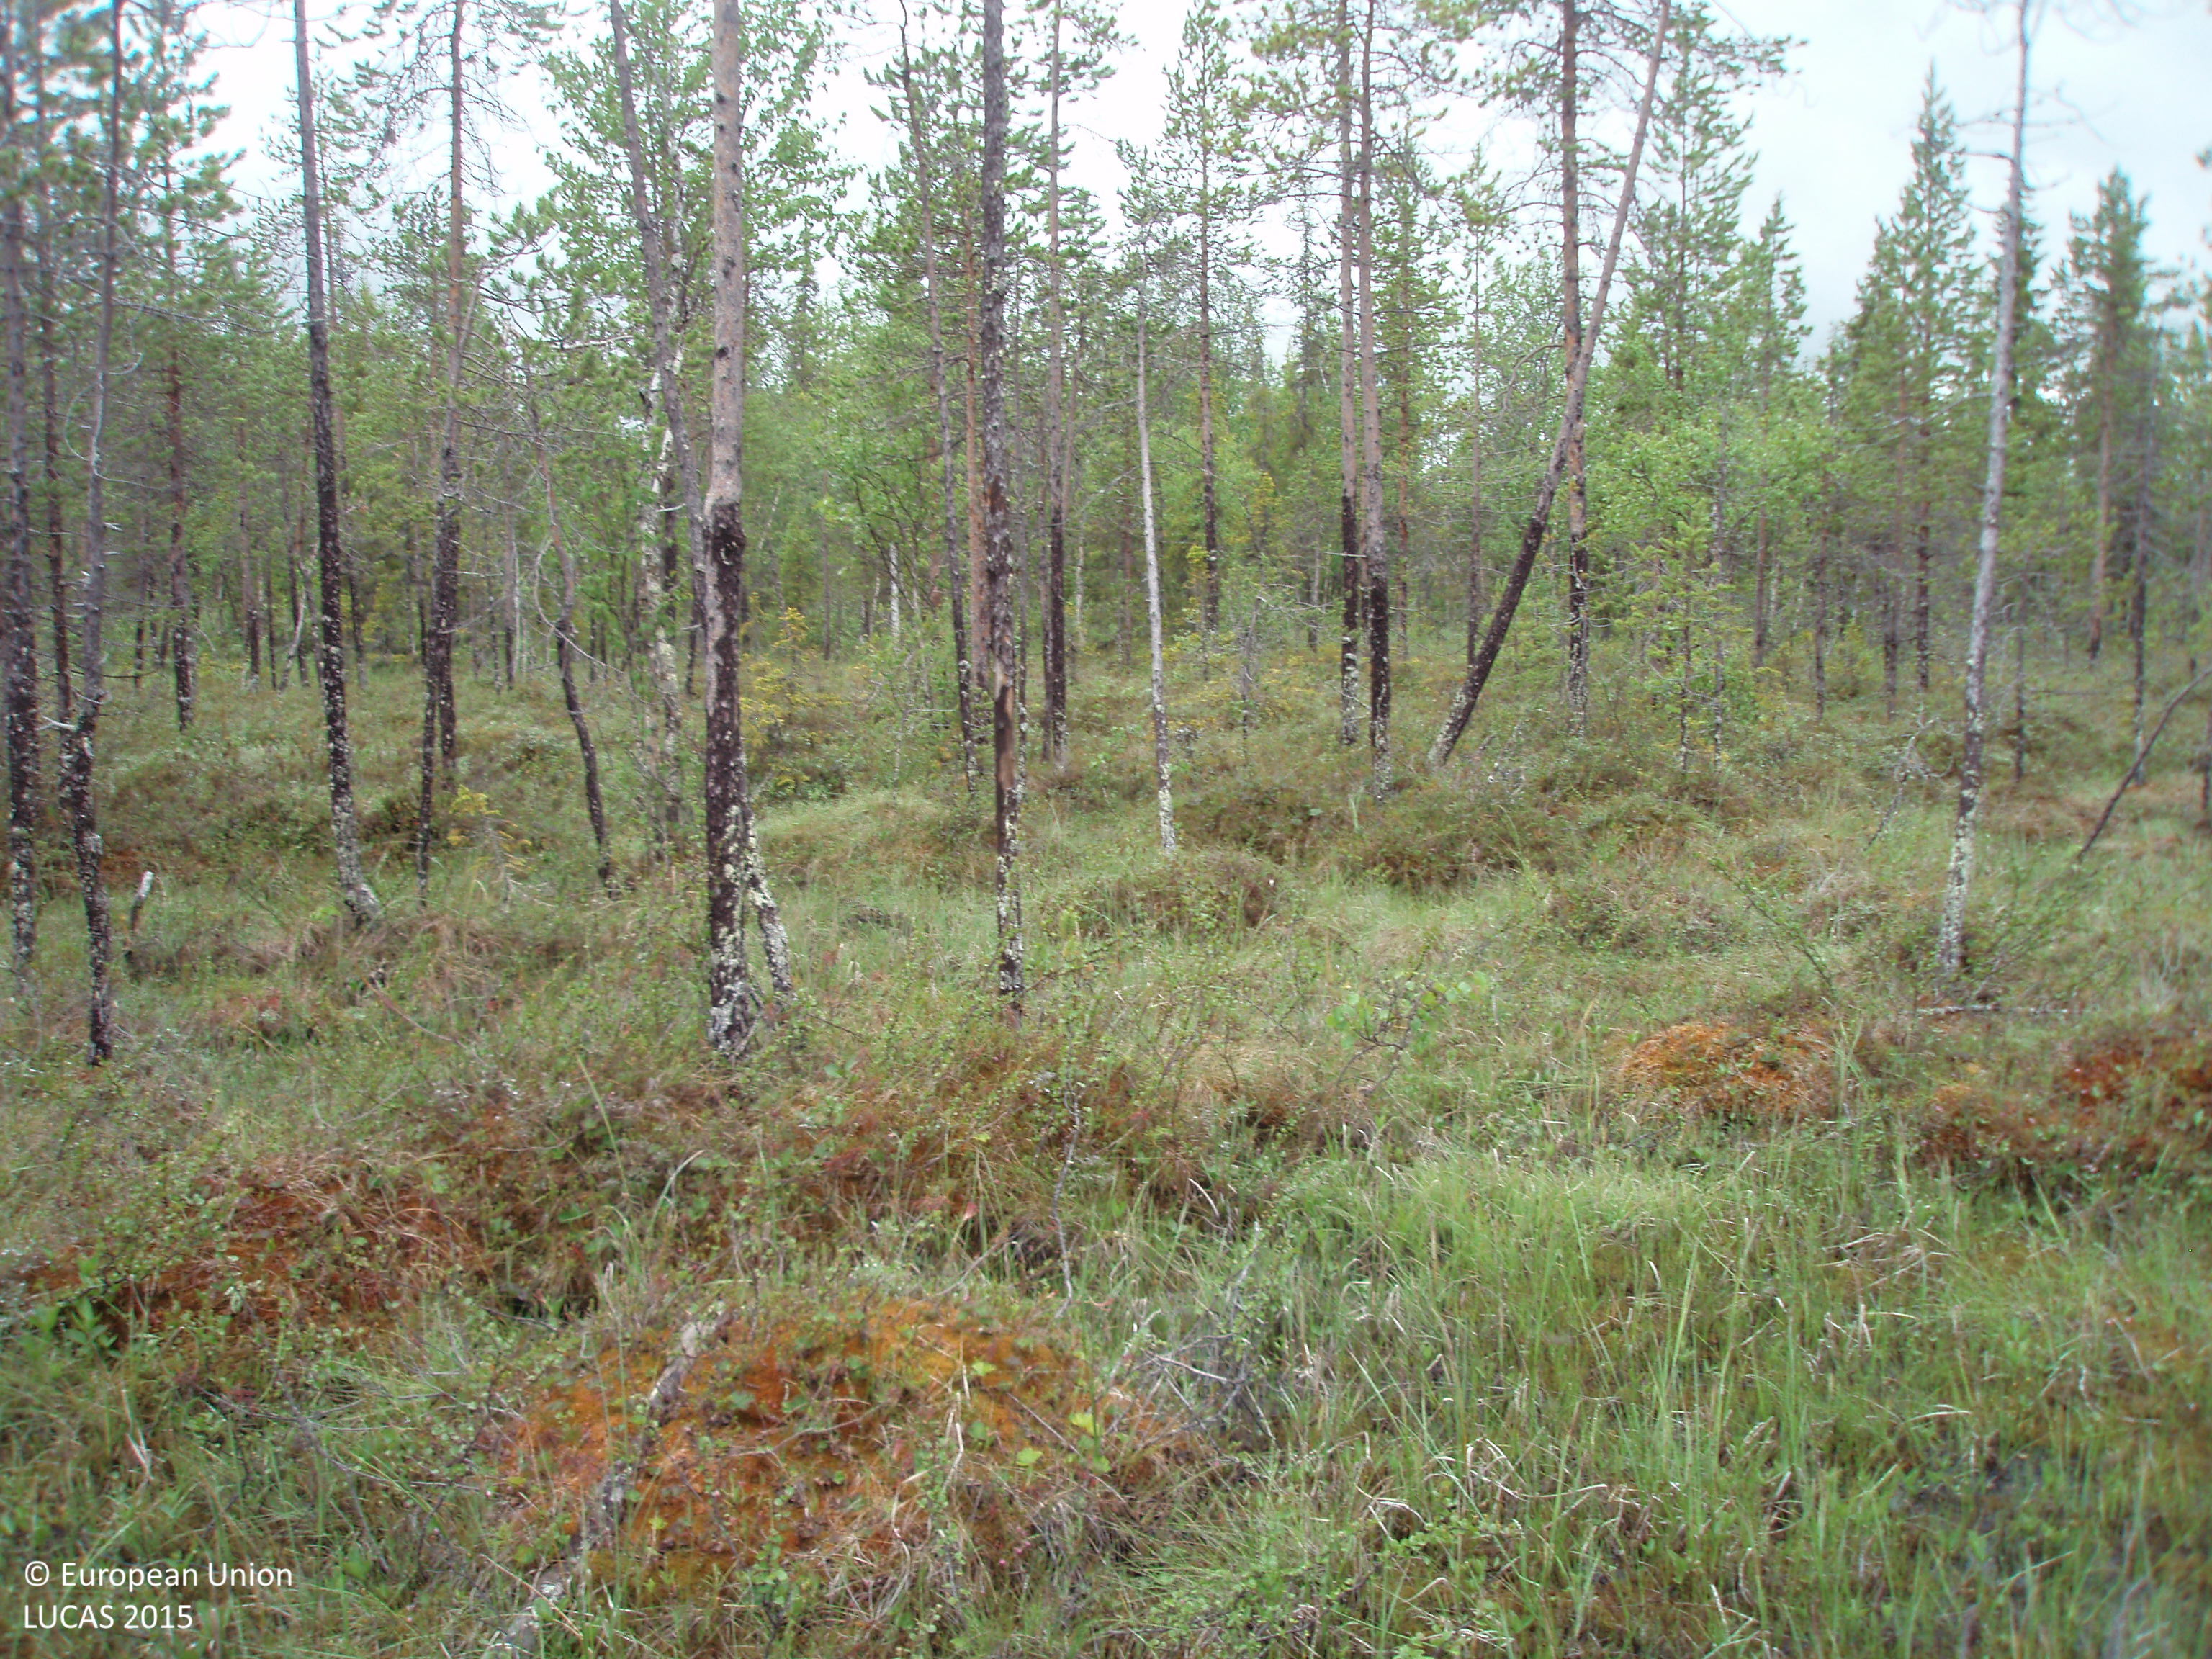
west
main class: Woodland
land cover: Pine dominated coniferous woodland
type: mire and swamp forests
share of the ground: 25 - 50 %
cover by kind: shrubs 70 %, coniferous forest trees 30 %
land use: Semi-natural and natural areas not in use
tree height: > 5 m
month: July
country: FI
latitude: 67.1717
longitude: 28.6403
